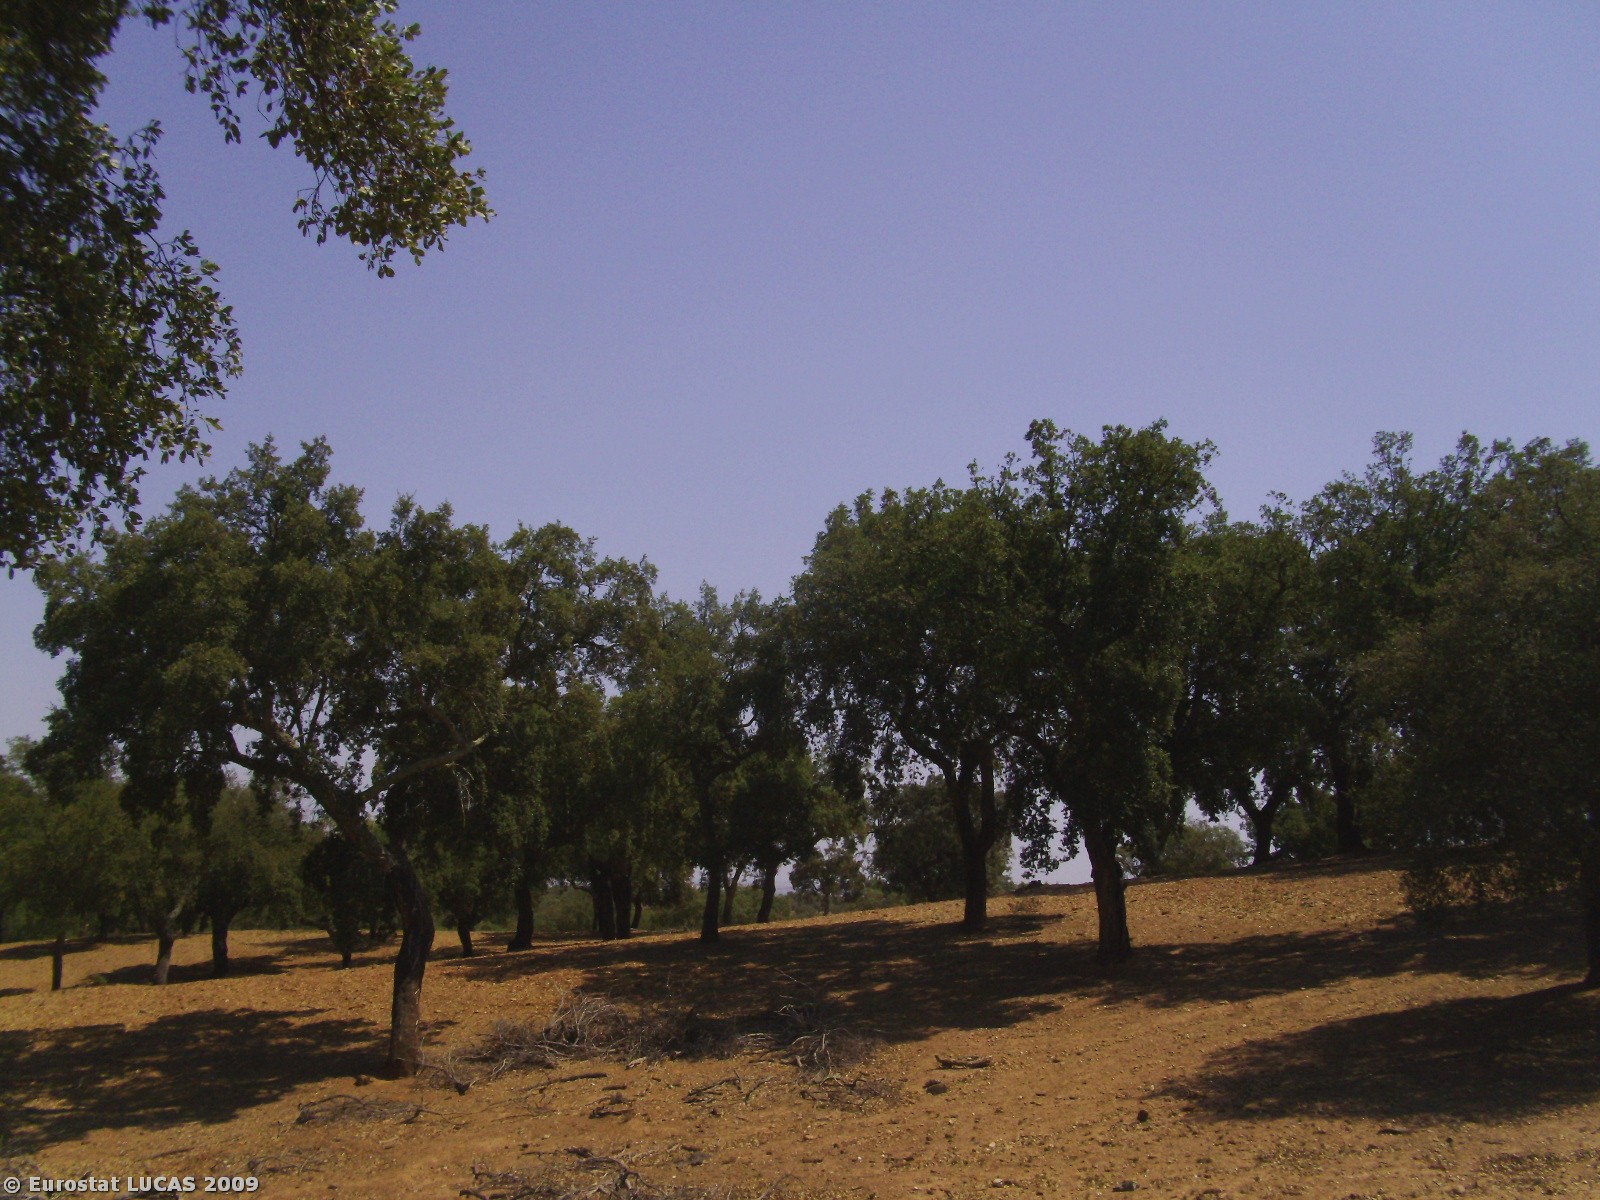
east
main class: Woodland
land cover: Broadleaved woodland
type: broadleaved evergreen forest
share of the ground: 10 - 25 %
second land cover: Bare land
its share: > 75 %
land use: Forestry
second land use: Agriculture (excluding fallow land and kitchen gardens)
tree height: > 5 m
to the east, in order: Broadleaved woodland; Bare land; Grassland with sparse tree/shrub cover; Broadleaved woodland
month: August
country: PT
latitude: 38.3646
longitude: -7.8072
